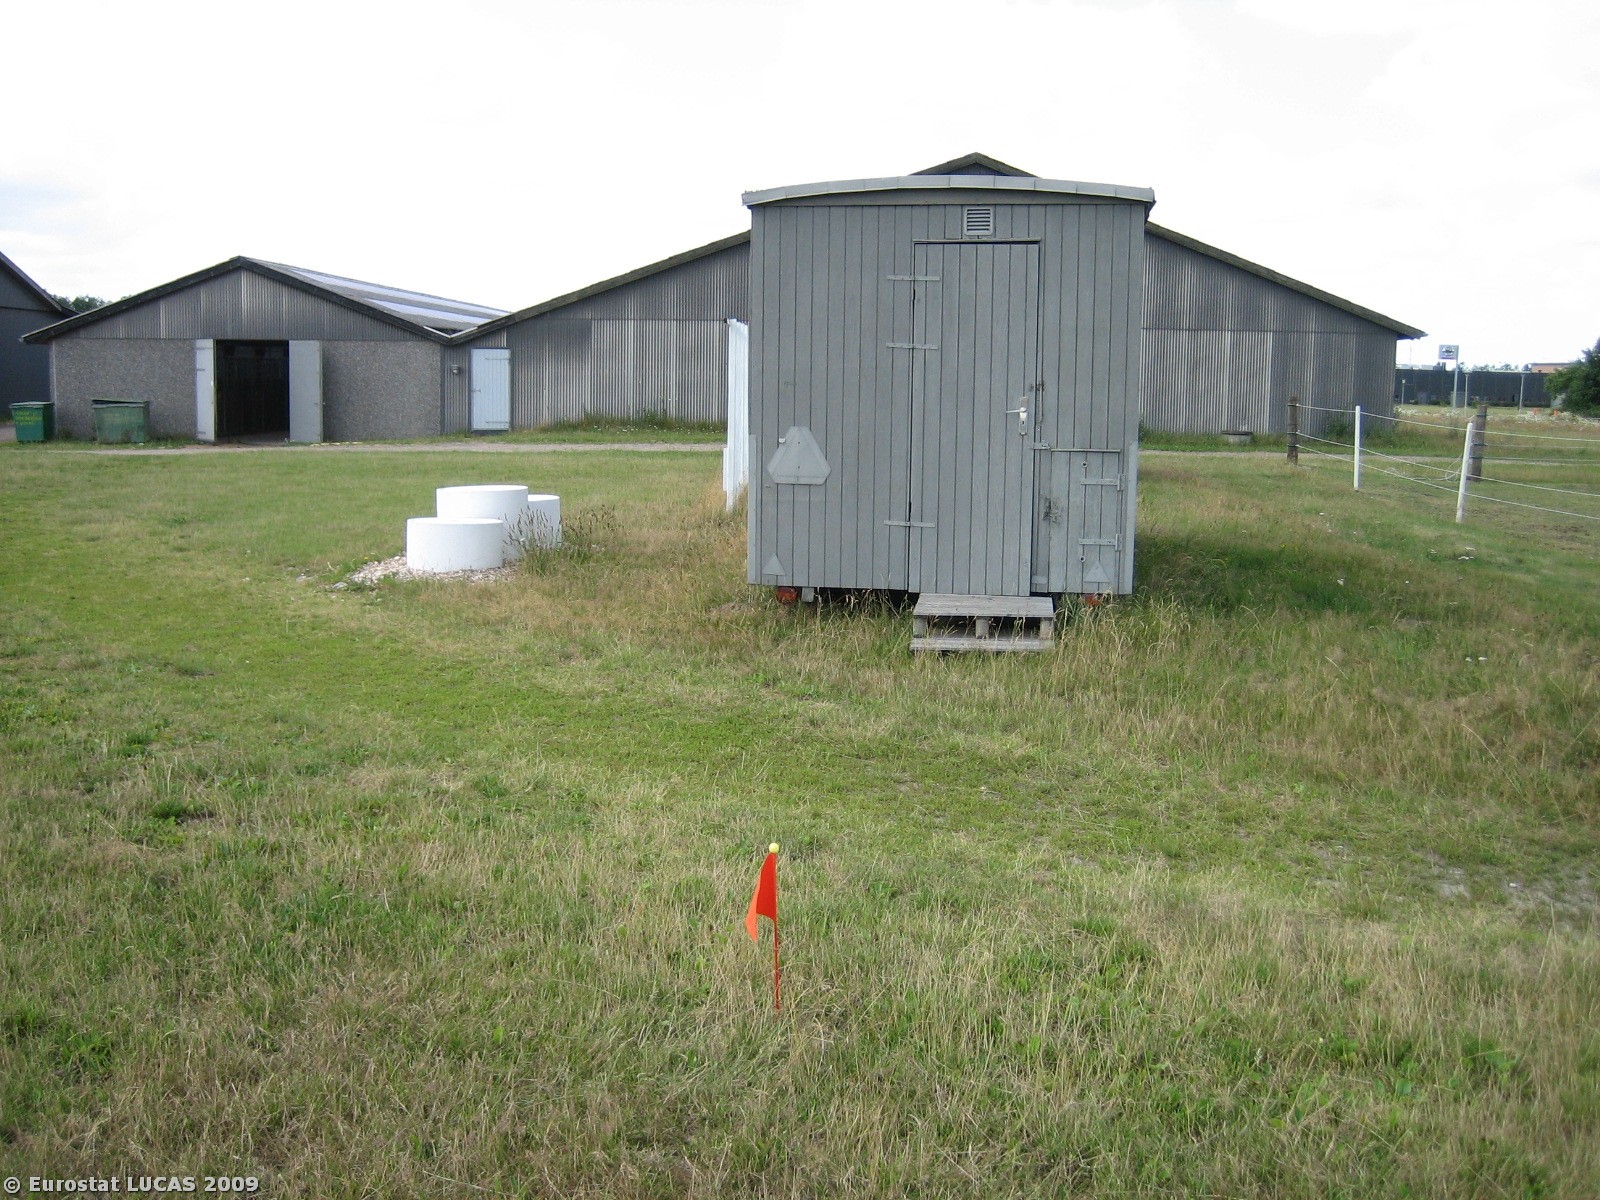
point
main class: Grassland
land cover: Grassland without tree/shrub cover
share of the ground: > 75 %
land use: Amenities, museums, leisure
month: July
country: DK
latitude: 55.7521
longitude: 8.9654
